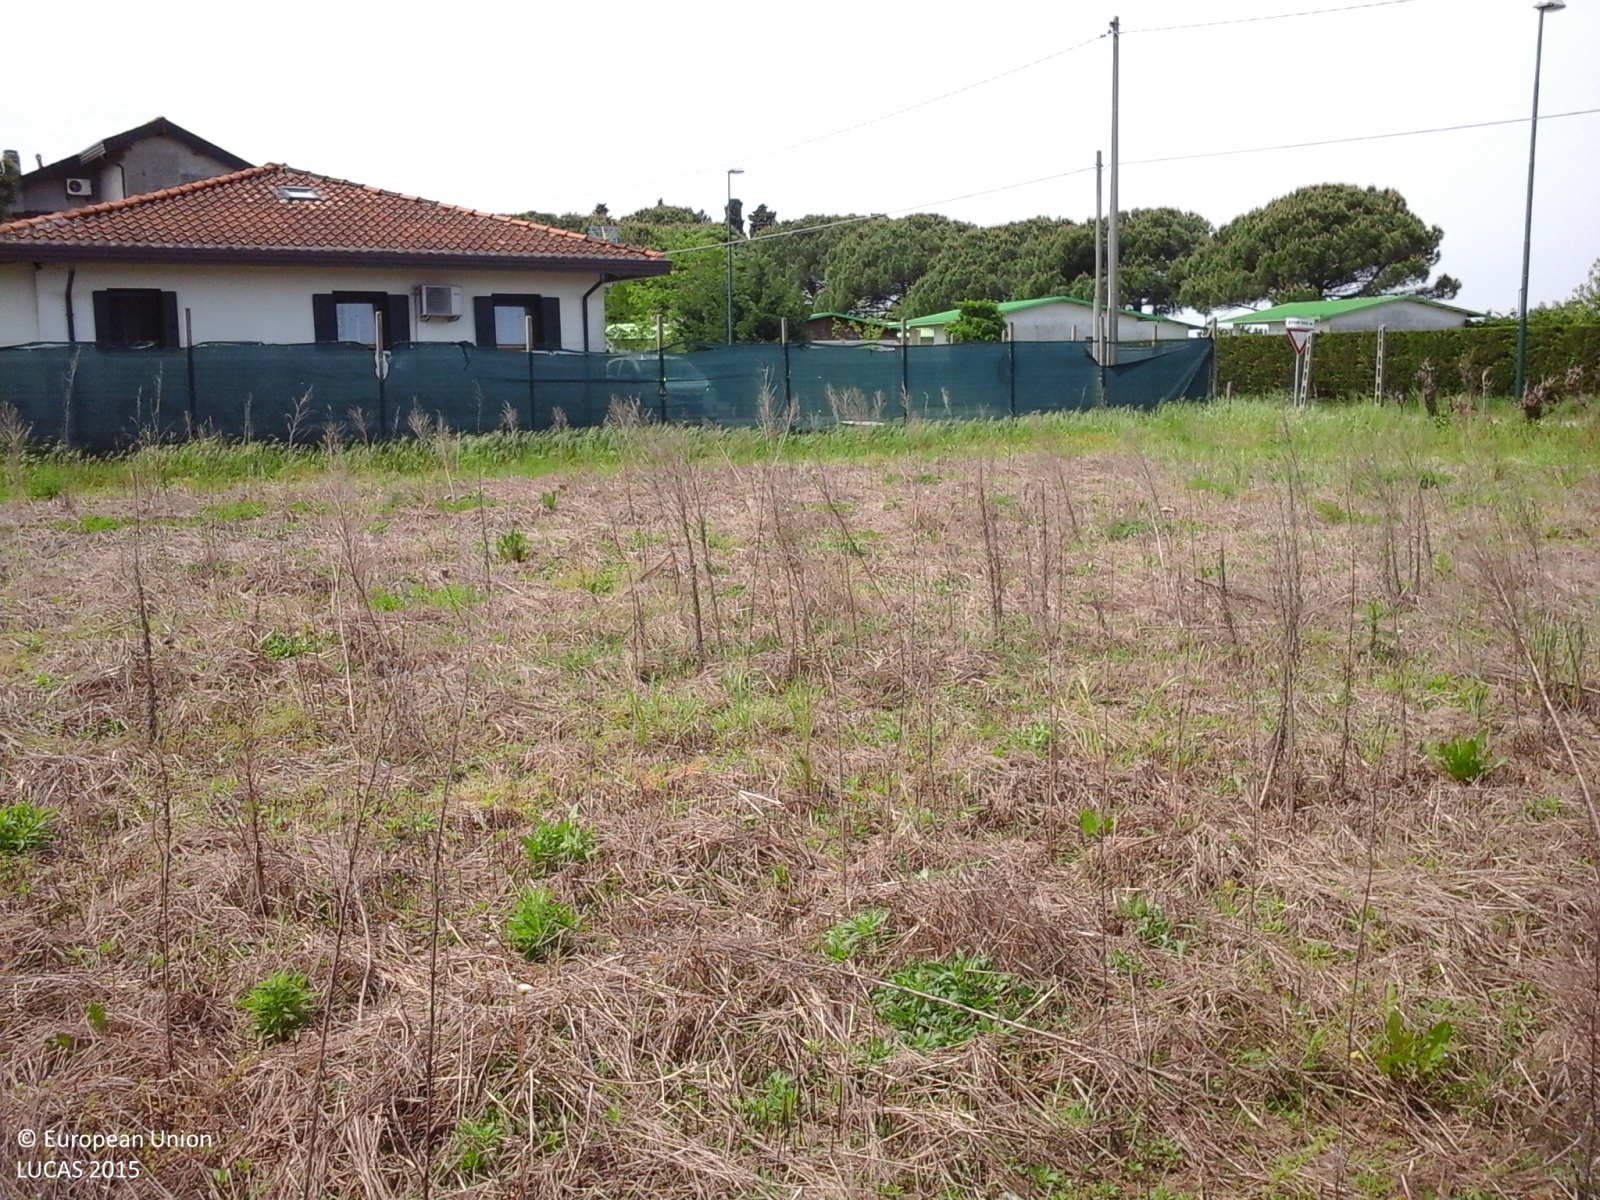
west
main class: Grassland
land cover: Spontaneously vegetated surfaces
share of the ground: 50 - 75 %
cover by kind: herbaceous plants 75 %, consolidated bare surface 25 %
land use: Fallow land
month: May
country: IT
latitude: 45.4402
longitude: 12.4380
